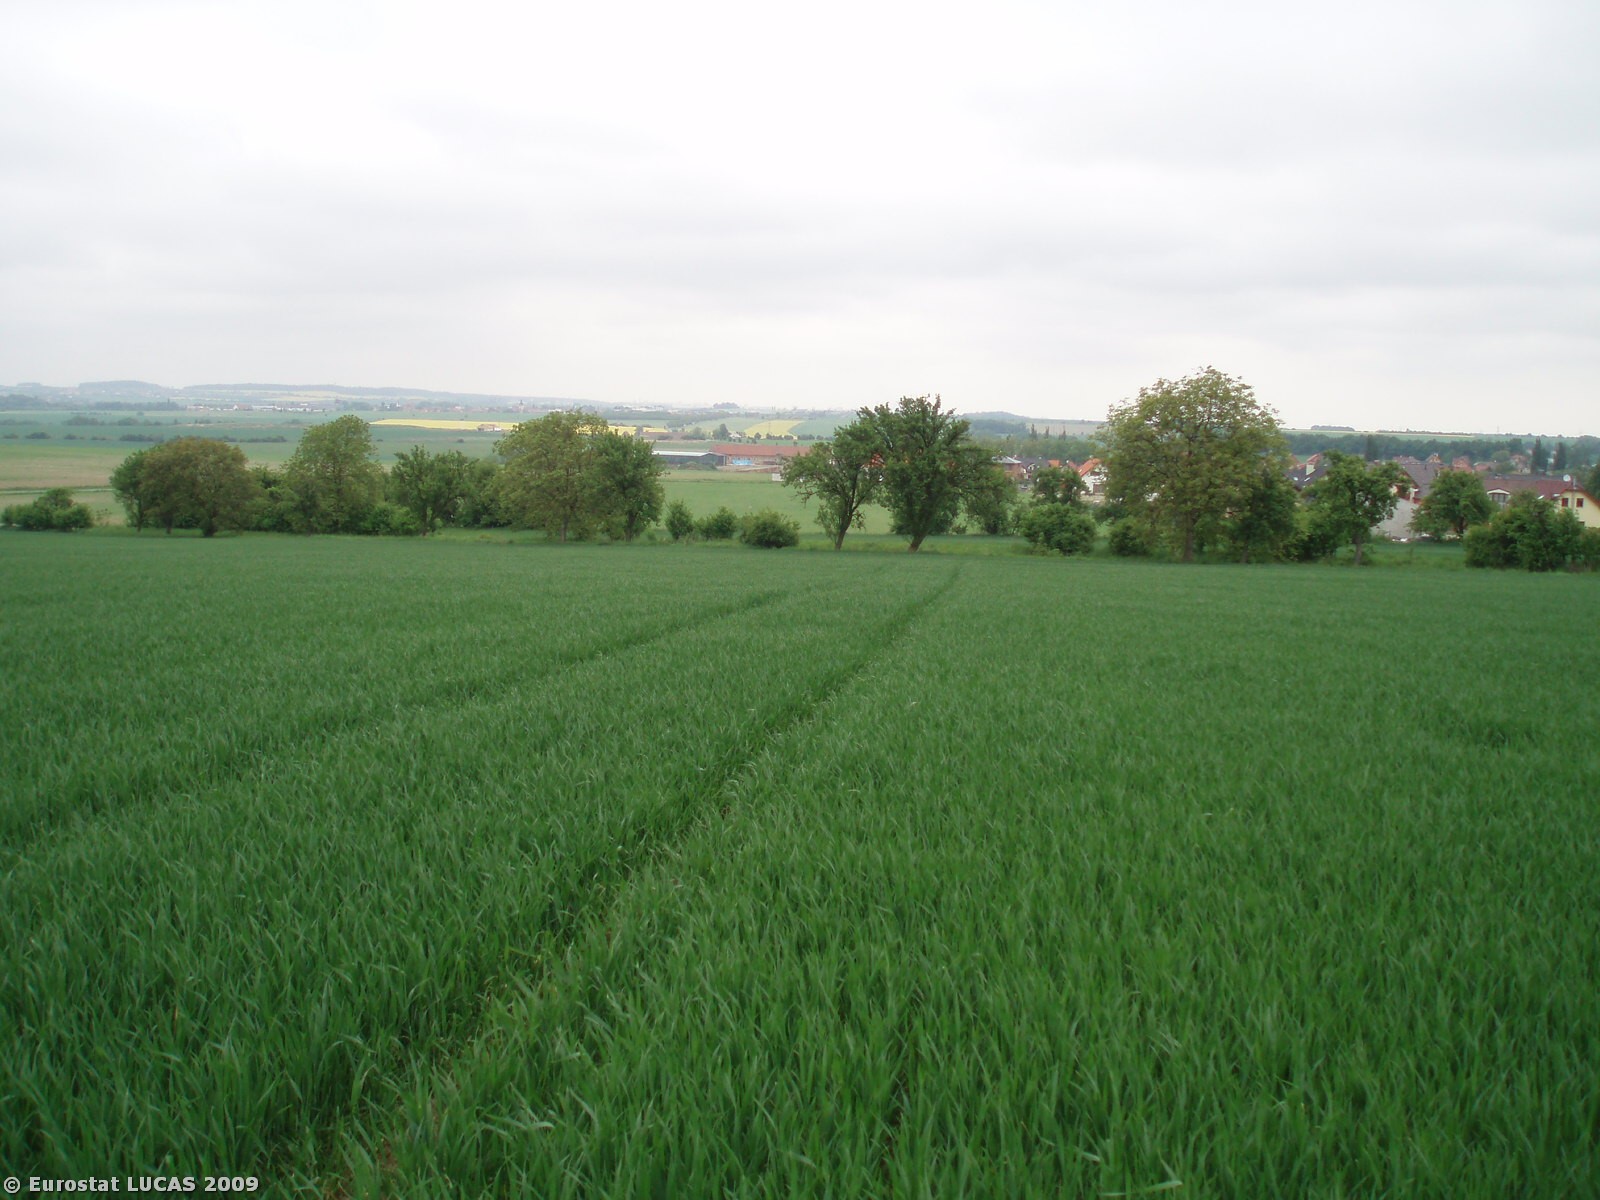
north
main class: Cropland
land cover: Common wheat
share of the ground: > 75 %
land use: Agriculture (excluding fallow land and kitchen gardens)
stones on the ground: < 10 %
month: May
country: CZ
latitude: 50.0547
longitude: 14.1493
